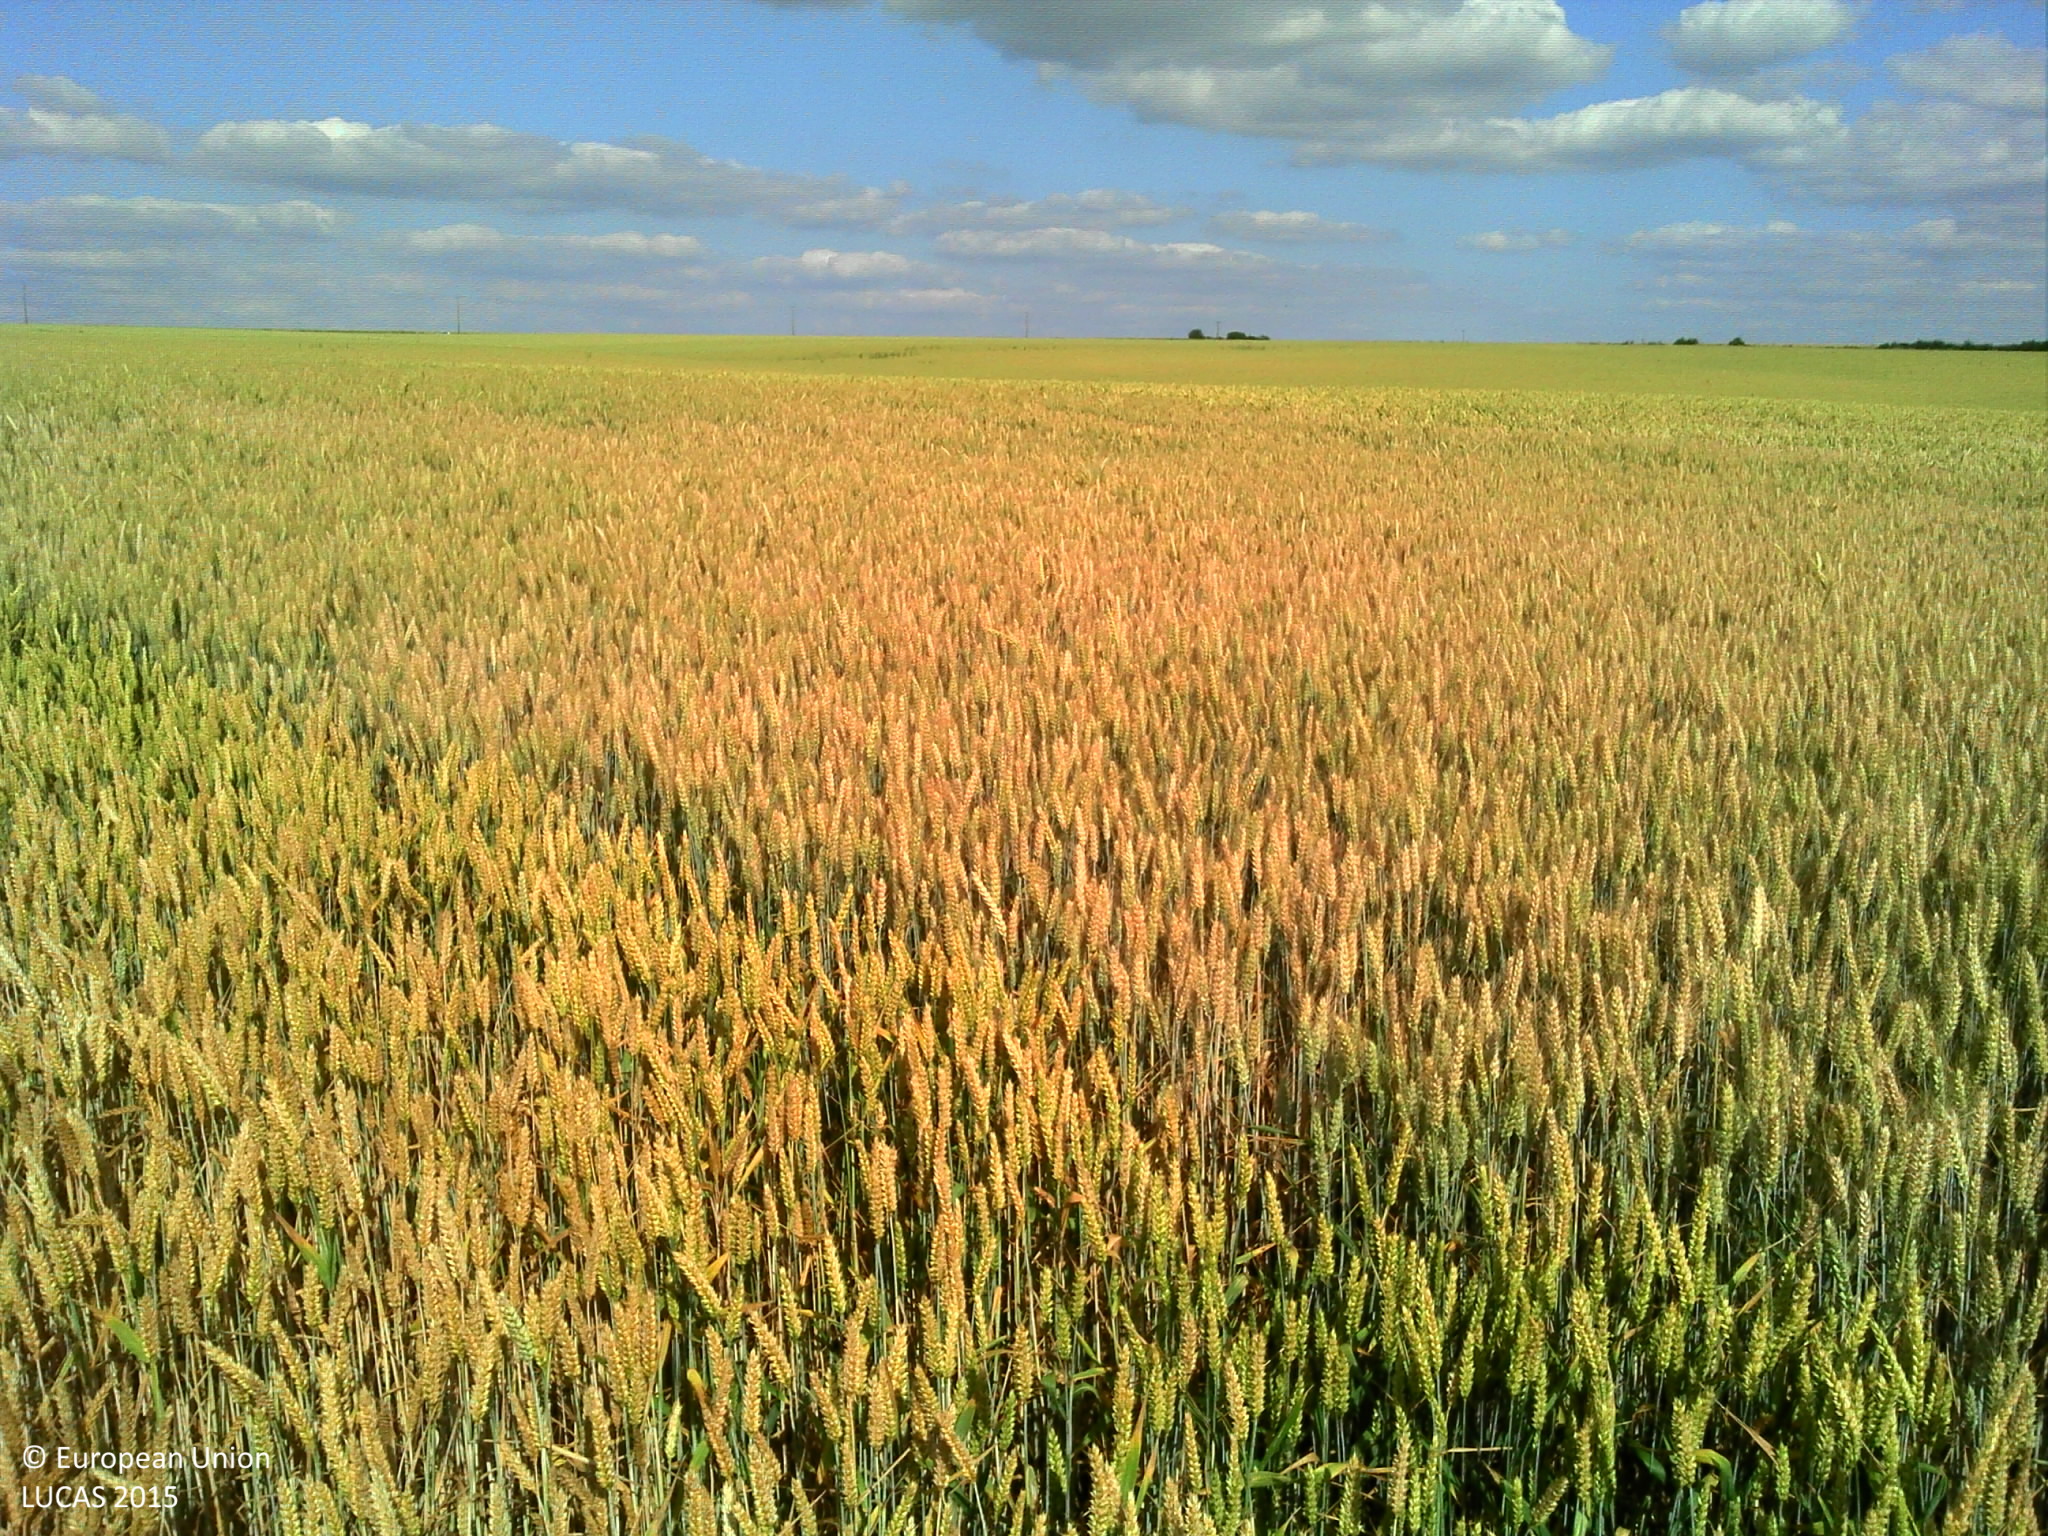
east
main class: Cropland
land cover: Common wheat
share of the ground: > 75 %
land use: Agriculture (excluding fallow land and kitchen gardens)
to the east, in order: Common wheat
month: July
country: FR
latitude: 50.2901
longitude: 2.1109
